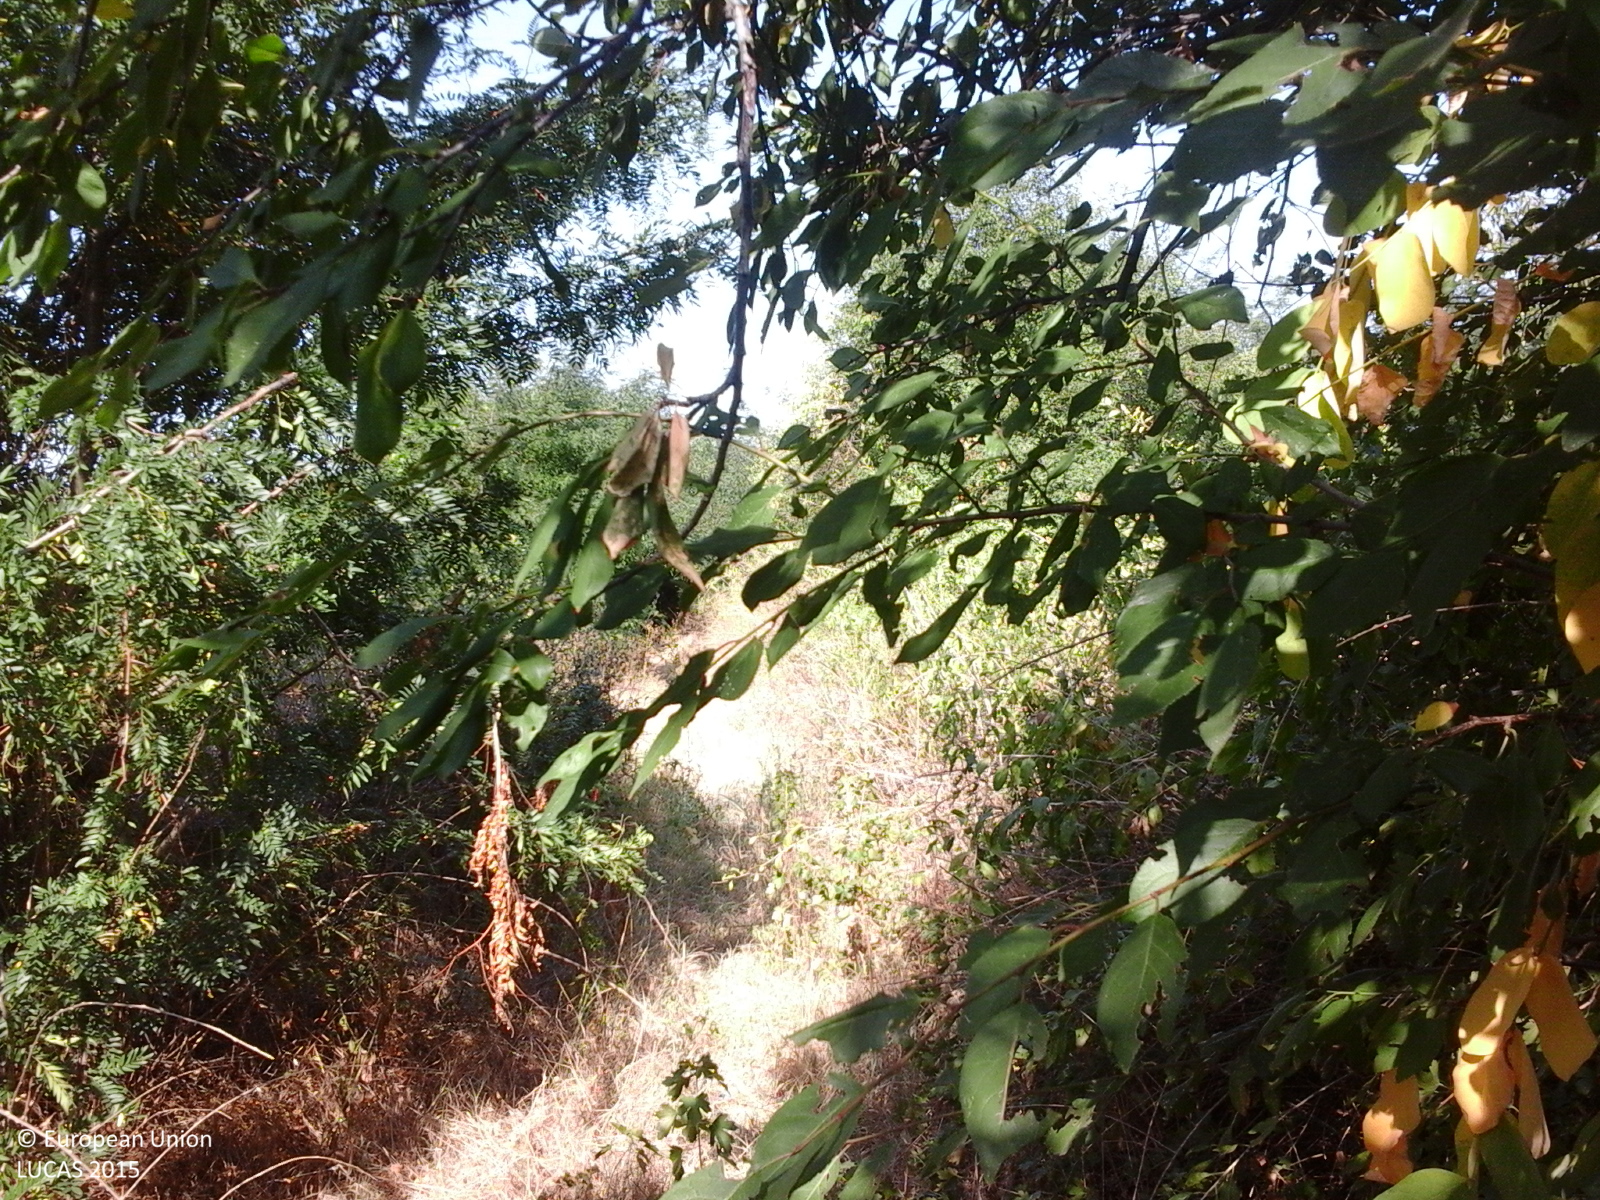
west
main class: Shrubland
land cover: Shrubland with sparse tree cover
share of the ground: > 75 %
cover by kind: shrubs 95 %, broadleaved forest trees 5 %
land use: Semi-natural and natural areas not in use
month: August
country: RO
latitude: 44.0650
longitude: 23.0896
